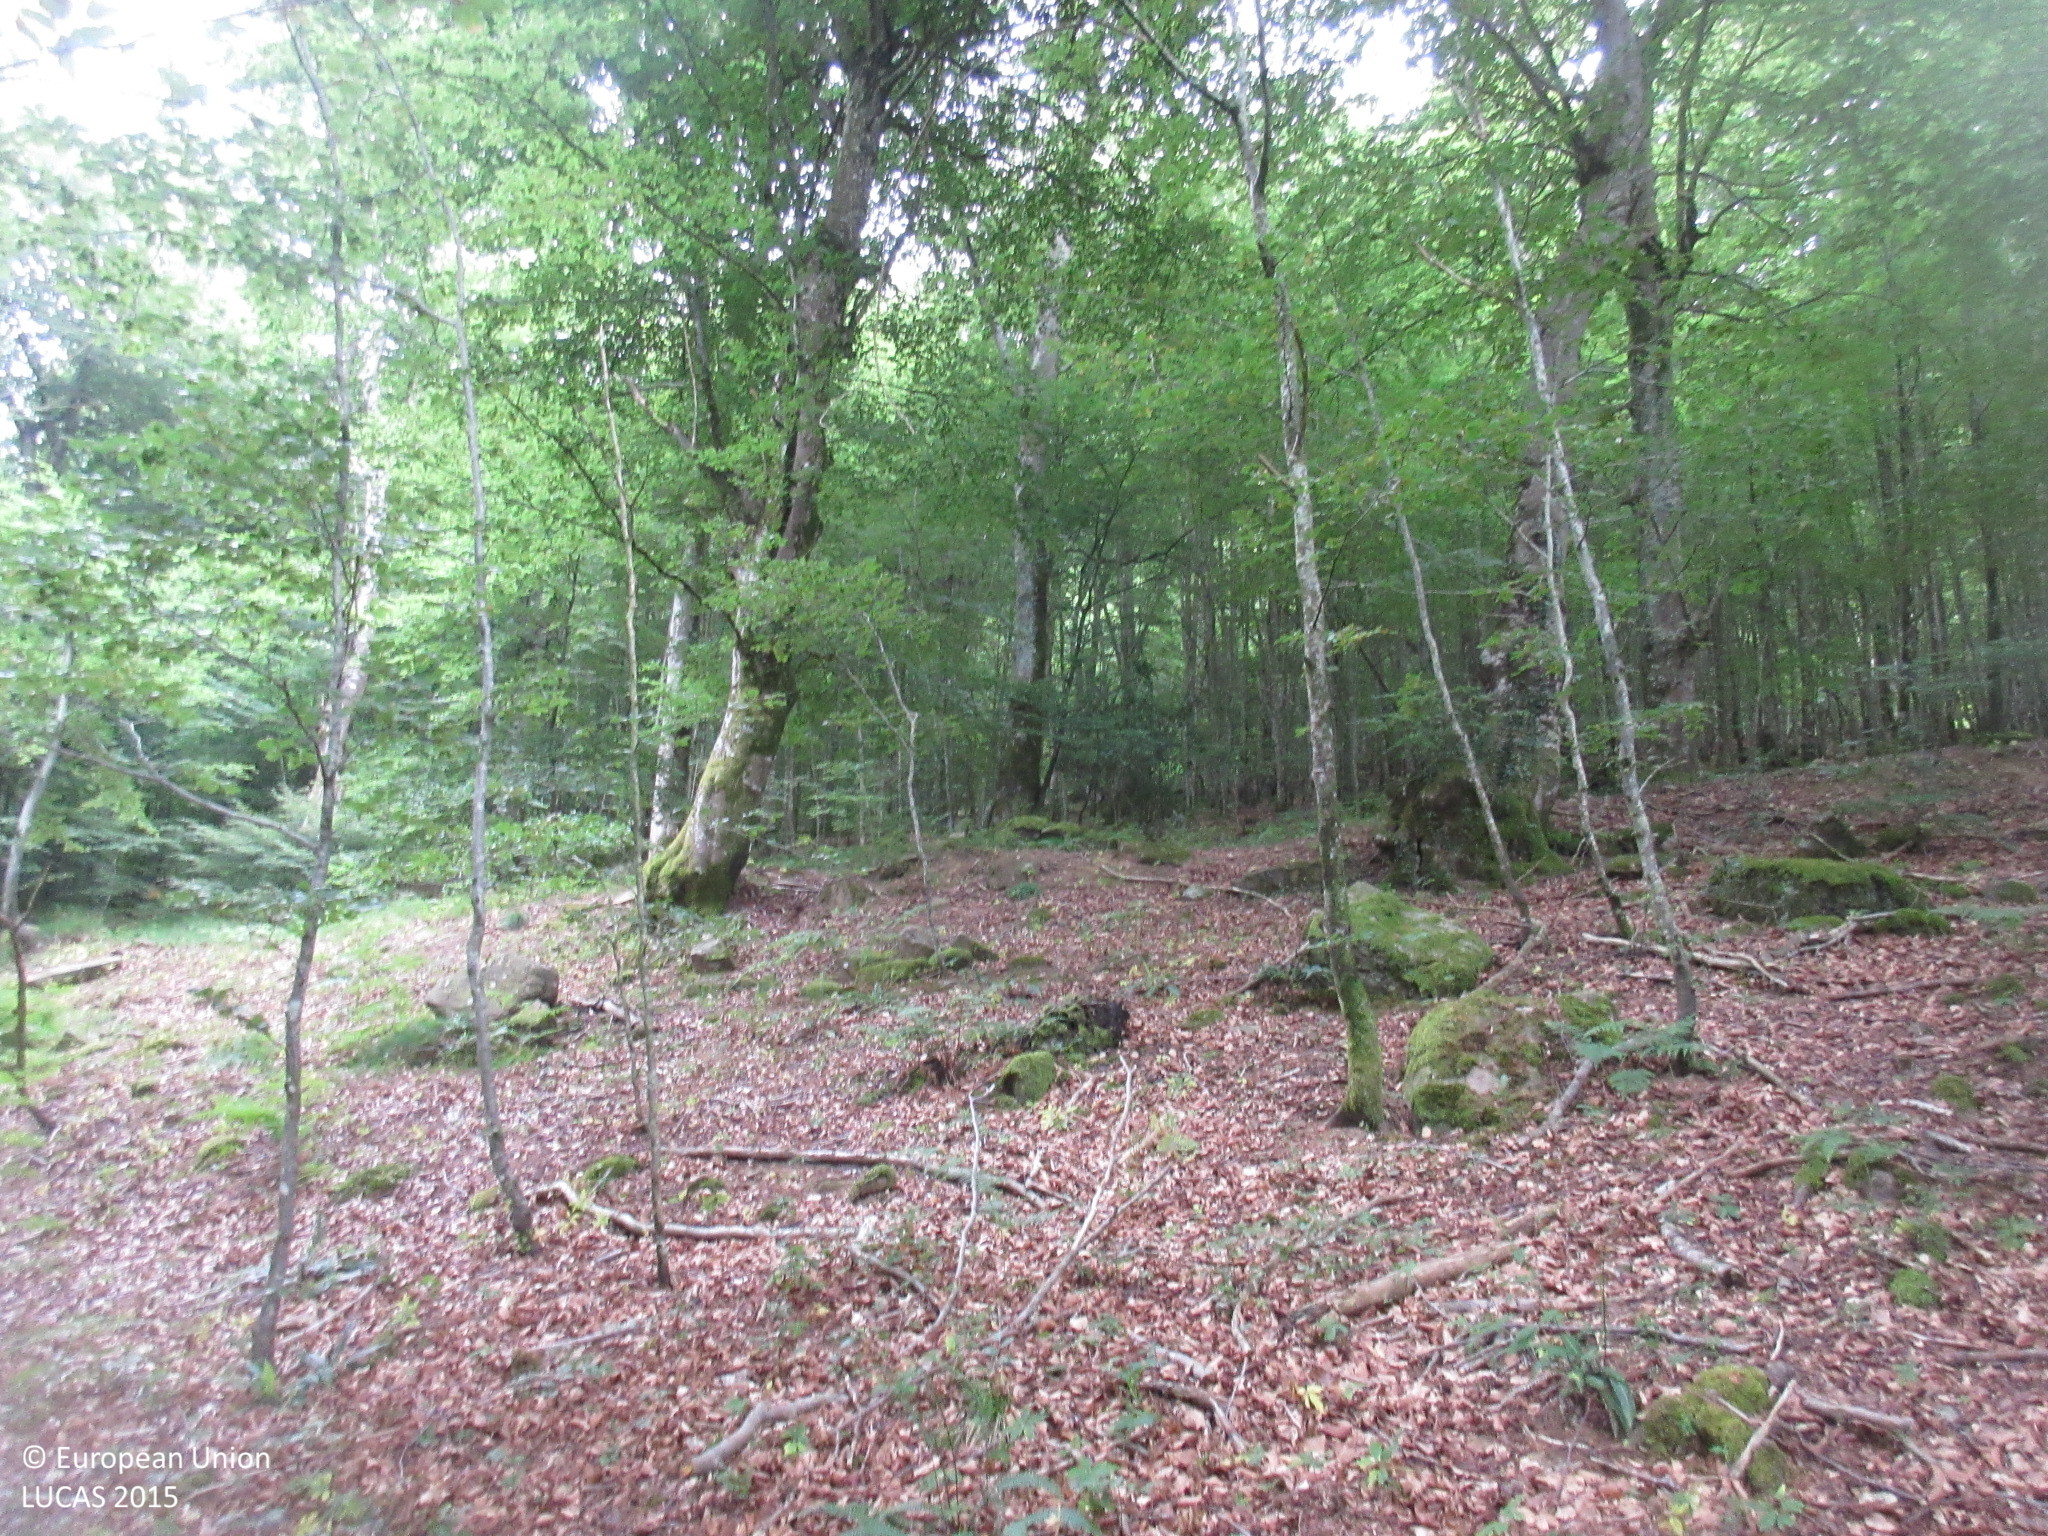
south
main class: Woodland
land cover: Broadleaved woodland
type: beech forest
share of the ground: > 75 %
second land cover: Shrubland without tree cover
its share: < 10 %
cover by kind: broadleaved forest trees 100 %
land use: Forestry
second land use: Agriculture (excluding fallow land and kitchen gardens)
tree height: > 5 m
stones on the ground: 10 - 25 %
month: July
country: ES
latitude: 43.0763
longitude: -4.0634
